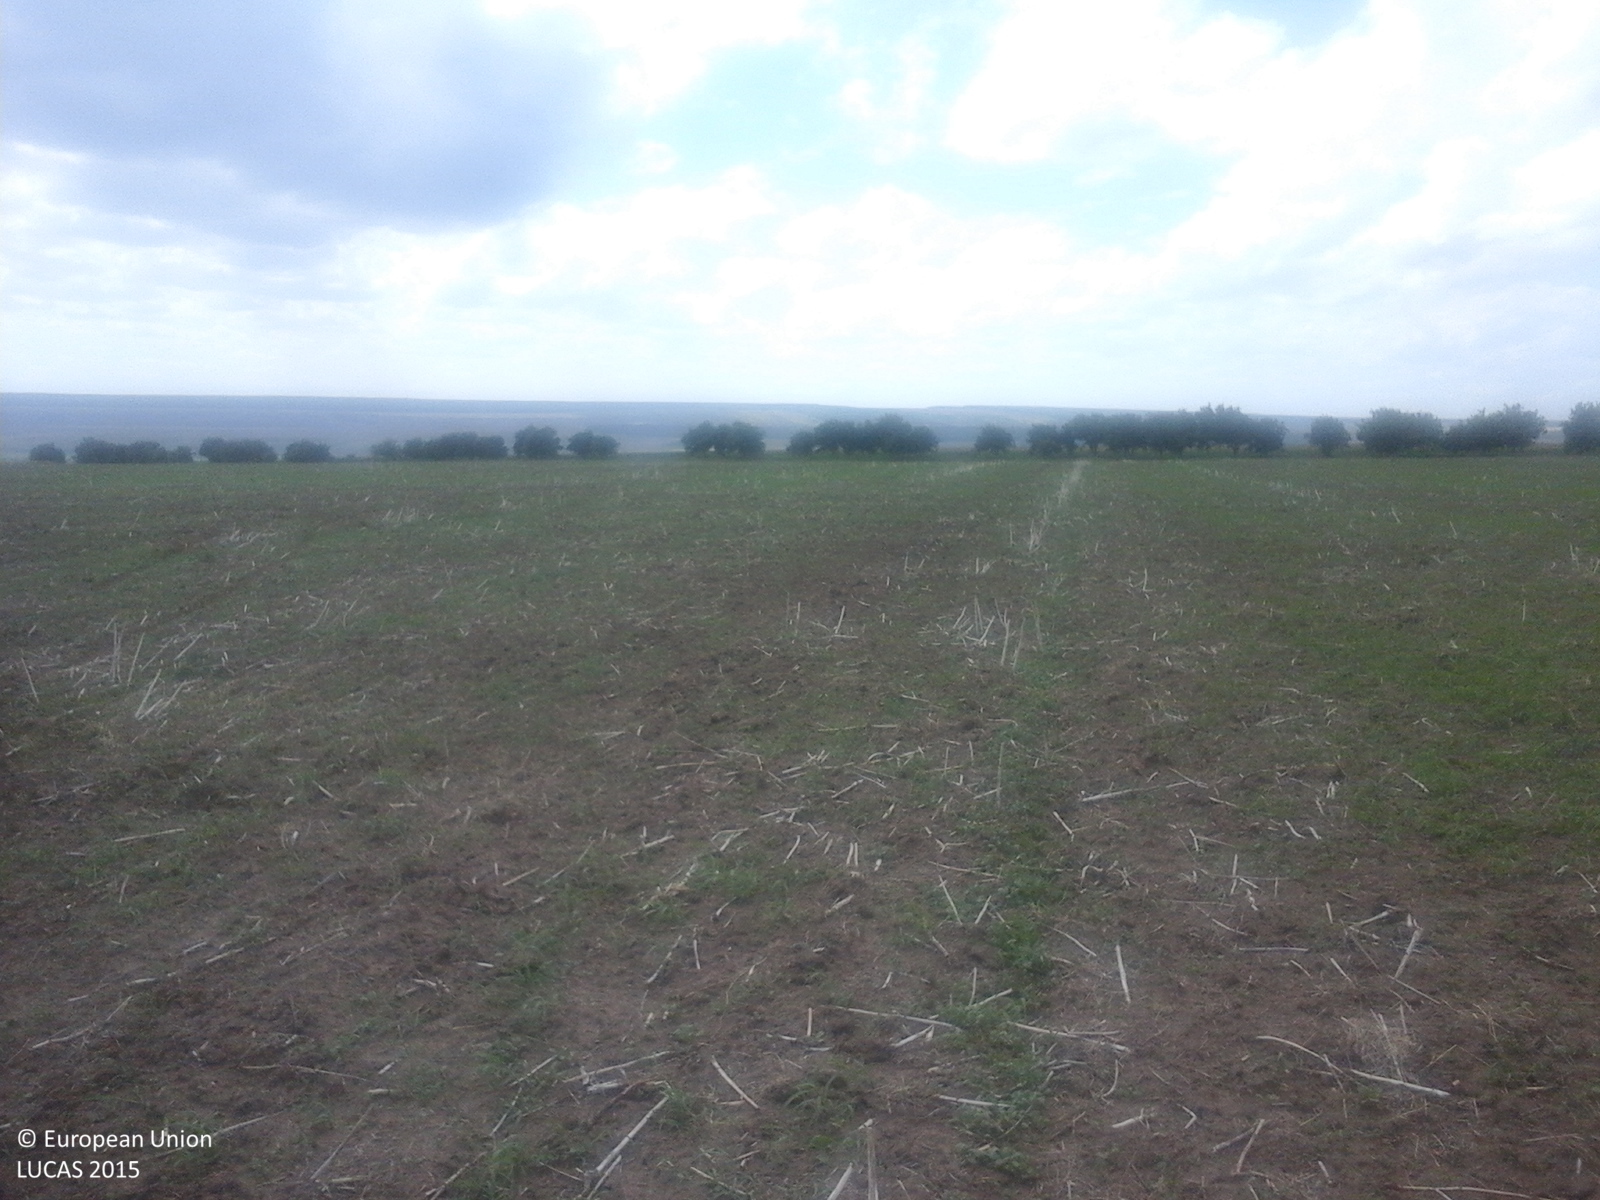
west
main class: Cropland
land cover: Rape and turnip rape
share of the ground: < 10 %
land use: Agriculture (excluding fallow land and kitchen gardens)
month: July
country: RO
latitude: 46.4355
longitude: 27.8607
